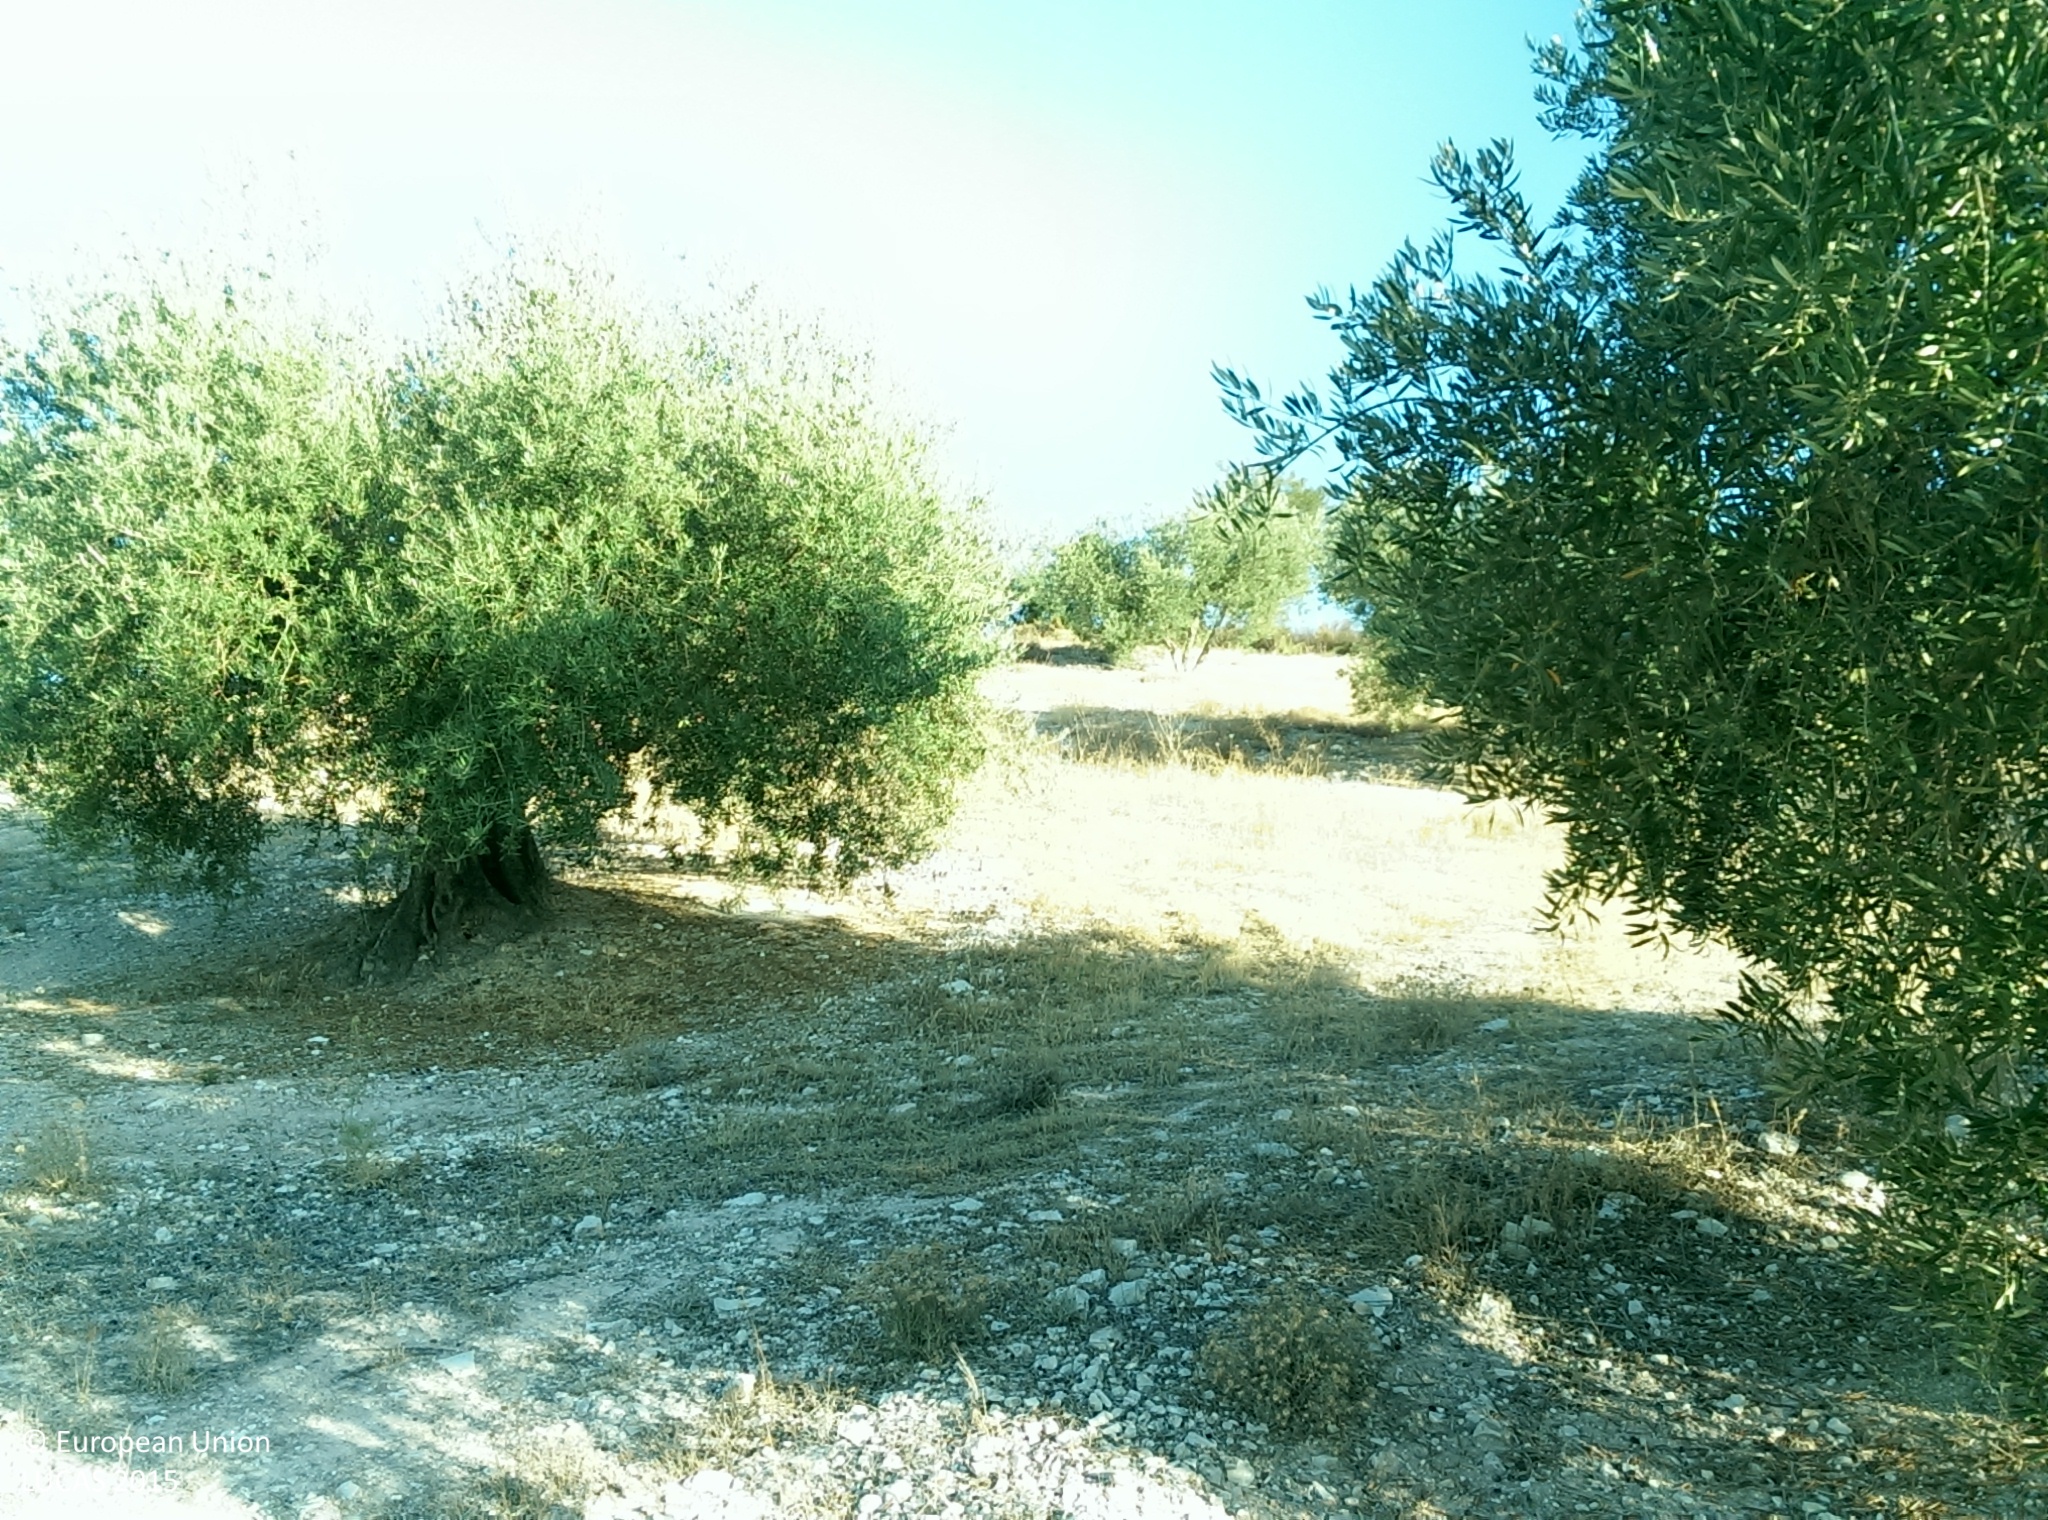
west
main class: Cropland
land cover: Olive groves
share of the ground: 25 - 50 %
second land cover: Spontaneously vegetated surfaces
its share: 10 - 25 %
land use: Agriculture (excluding fallow land and kitchen gardens)
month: July
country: ES
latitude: 37.3554
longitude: -3.7103
